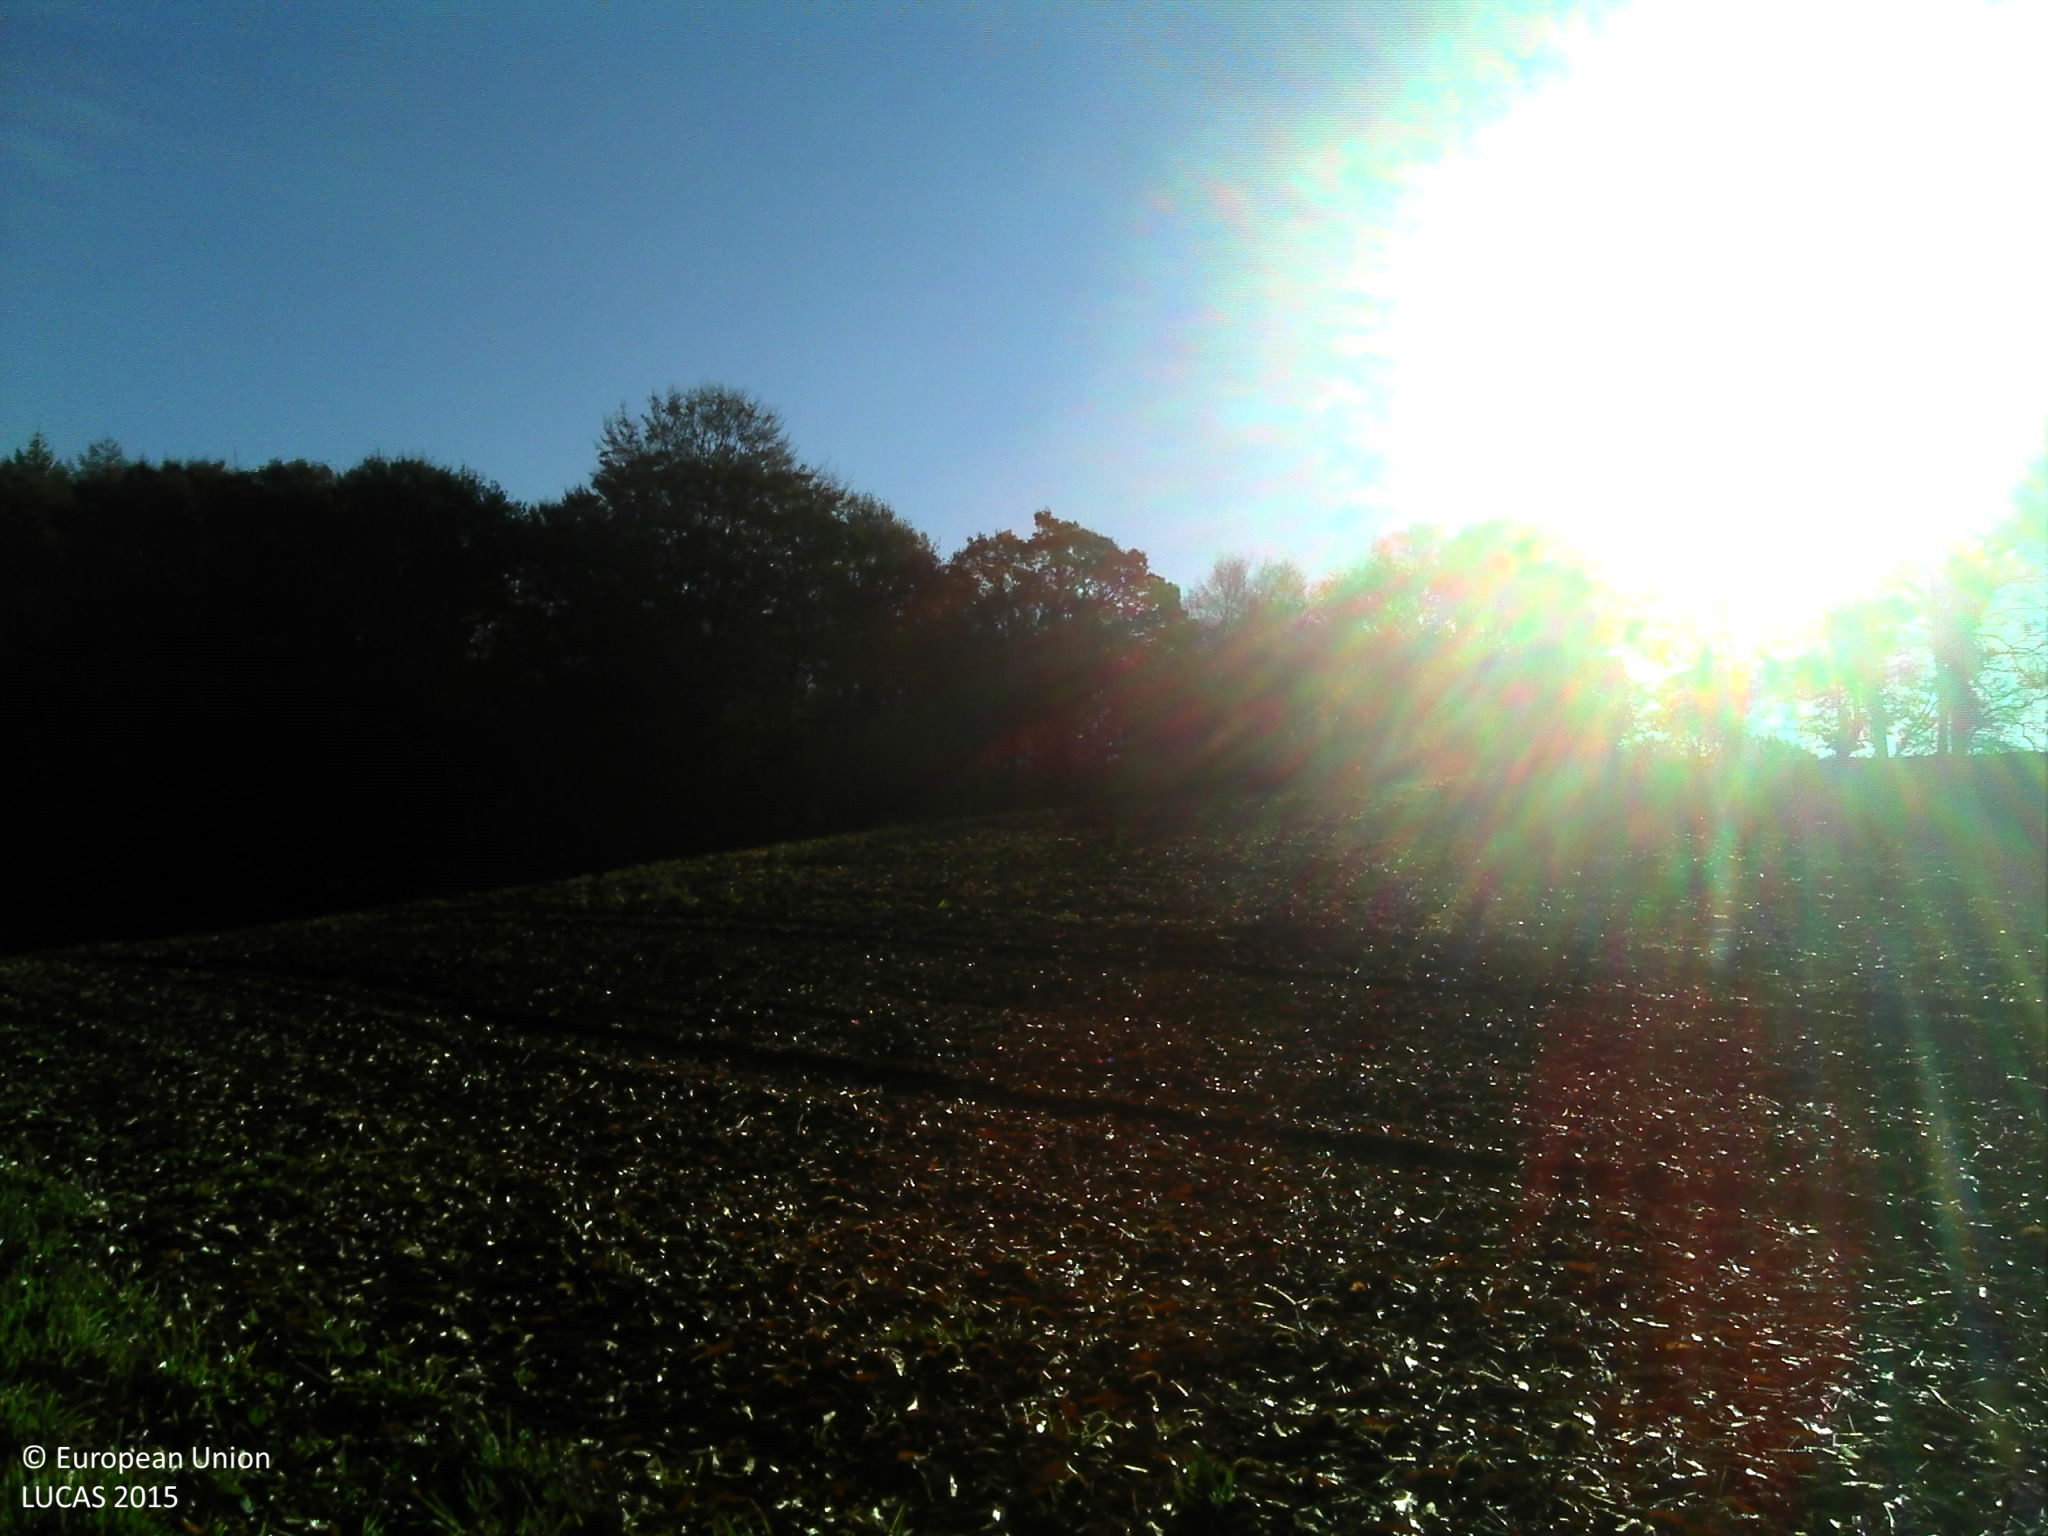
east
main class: Woodland
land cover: Broadleaved woodland
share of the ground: > 75 %
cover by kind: broadleaved forest trees 100 %
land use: Forestry
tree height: > 5 m
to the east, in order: Broadleaved woodland; Common wheat; Broadleaved woodland; Spruce dominated mixed woodland; Broadleaved woodland
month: November
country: FR
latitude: 48.1091
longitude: -3.2757
